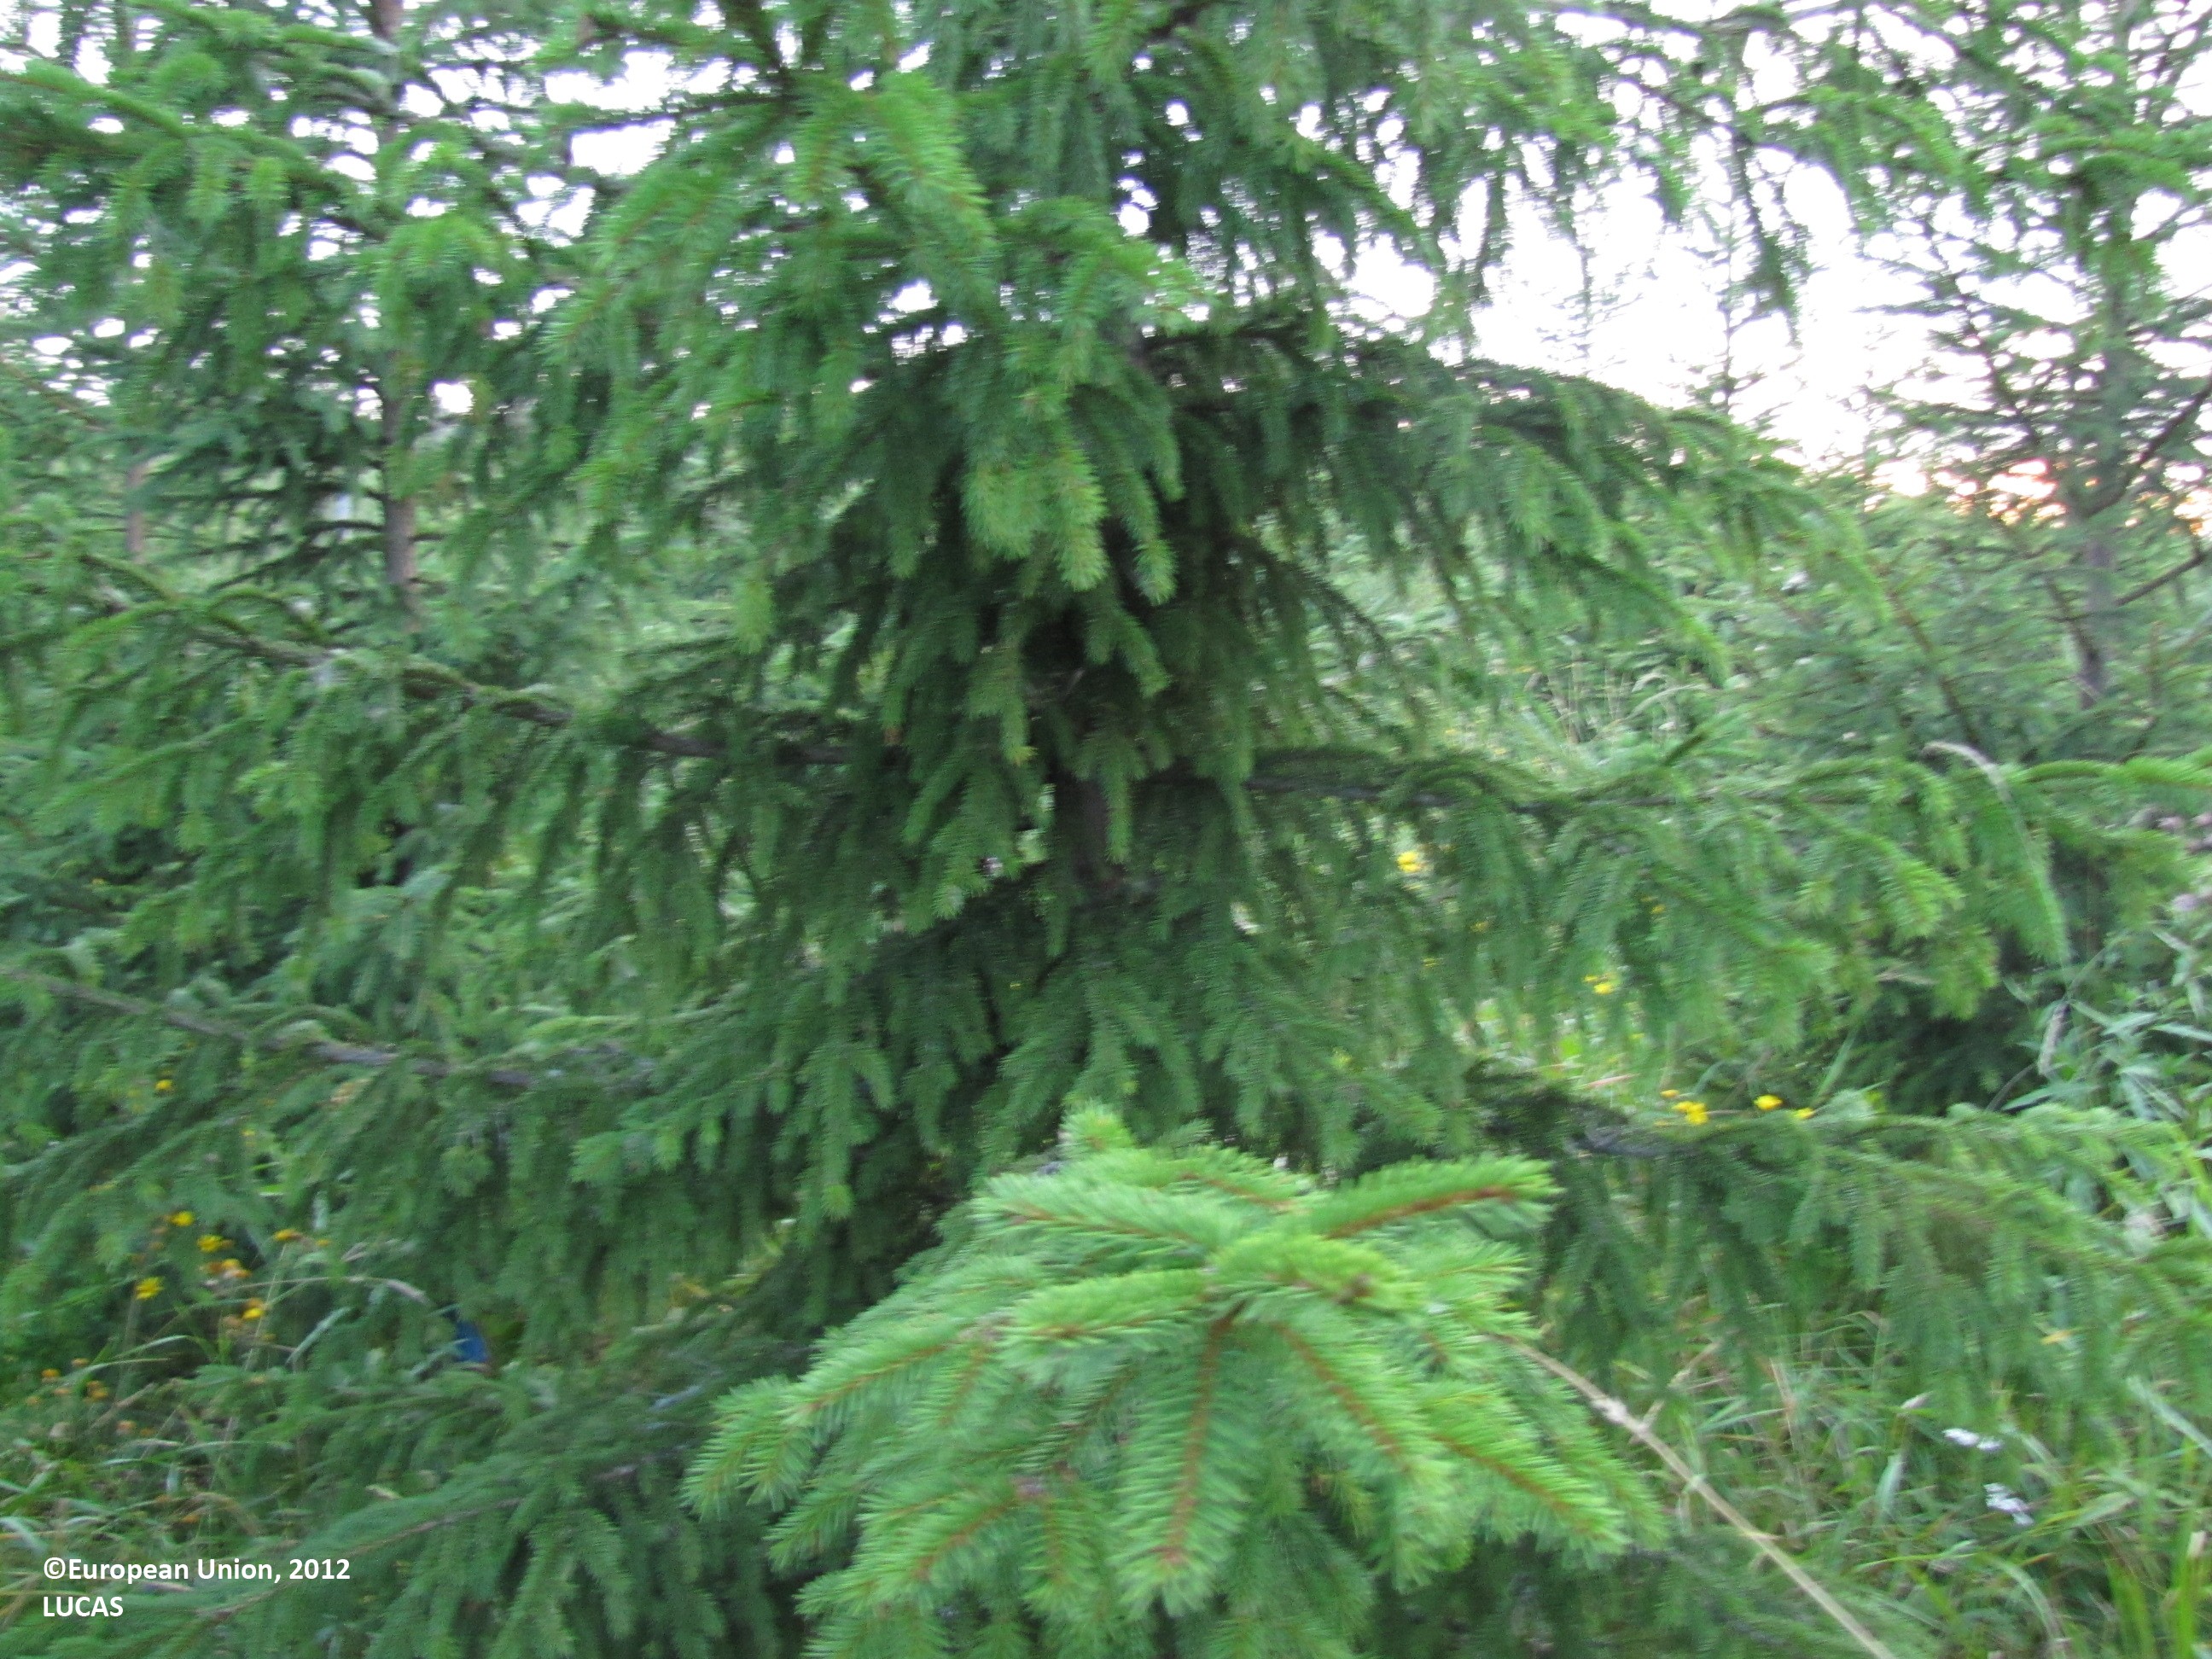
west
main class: Woodland
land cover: Spruce dominated coniferous woodland
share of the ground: 50 - 75 %
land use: Forestry
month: August
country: FI
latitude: 61.4412
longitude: 23.6014
